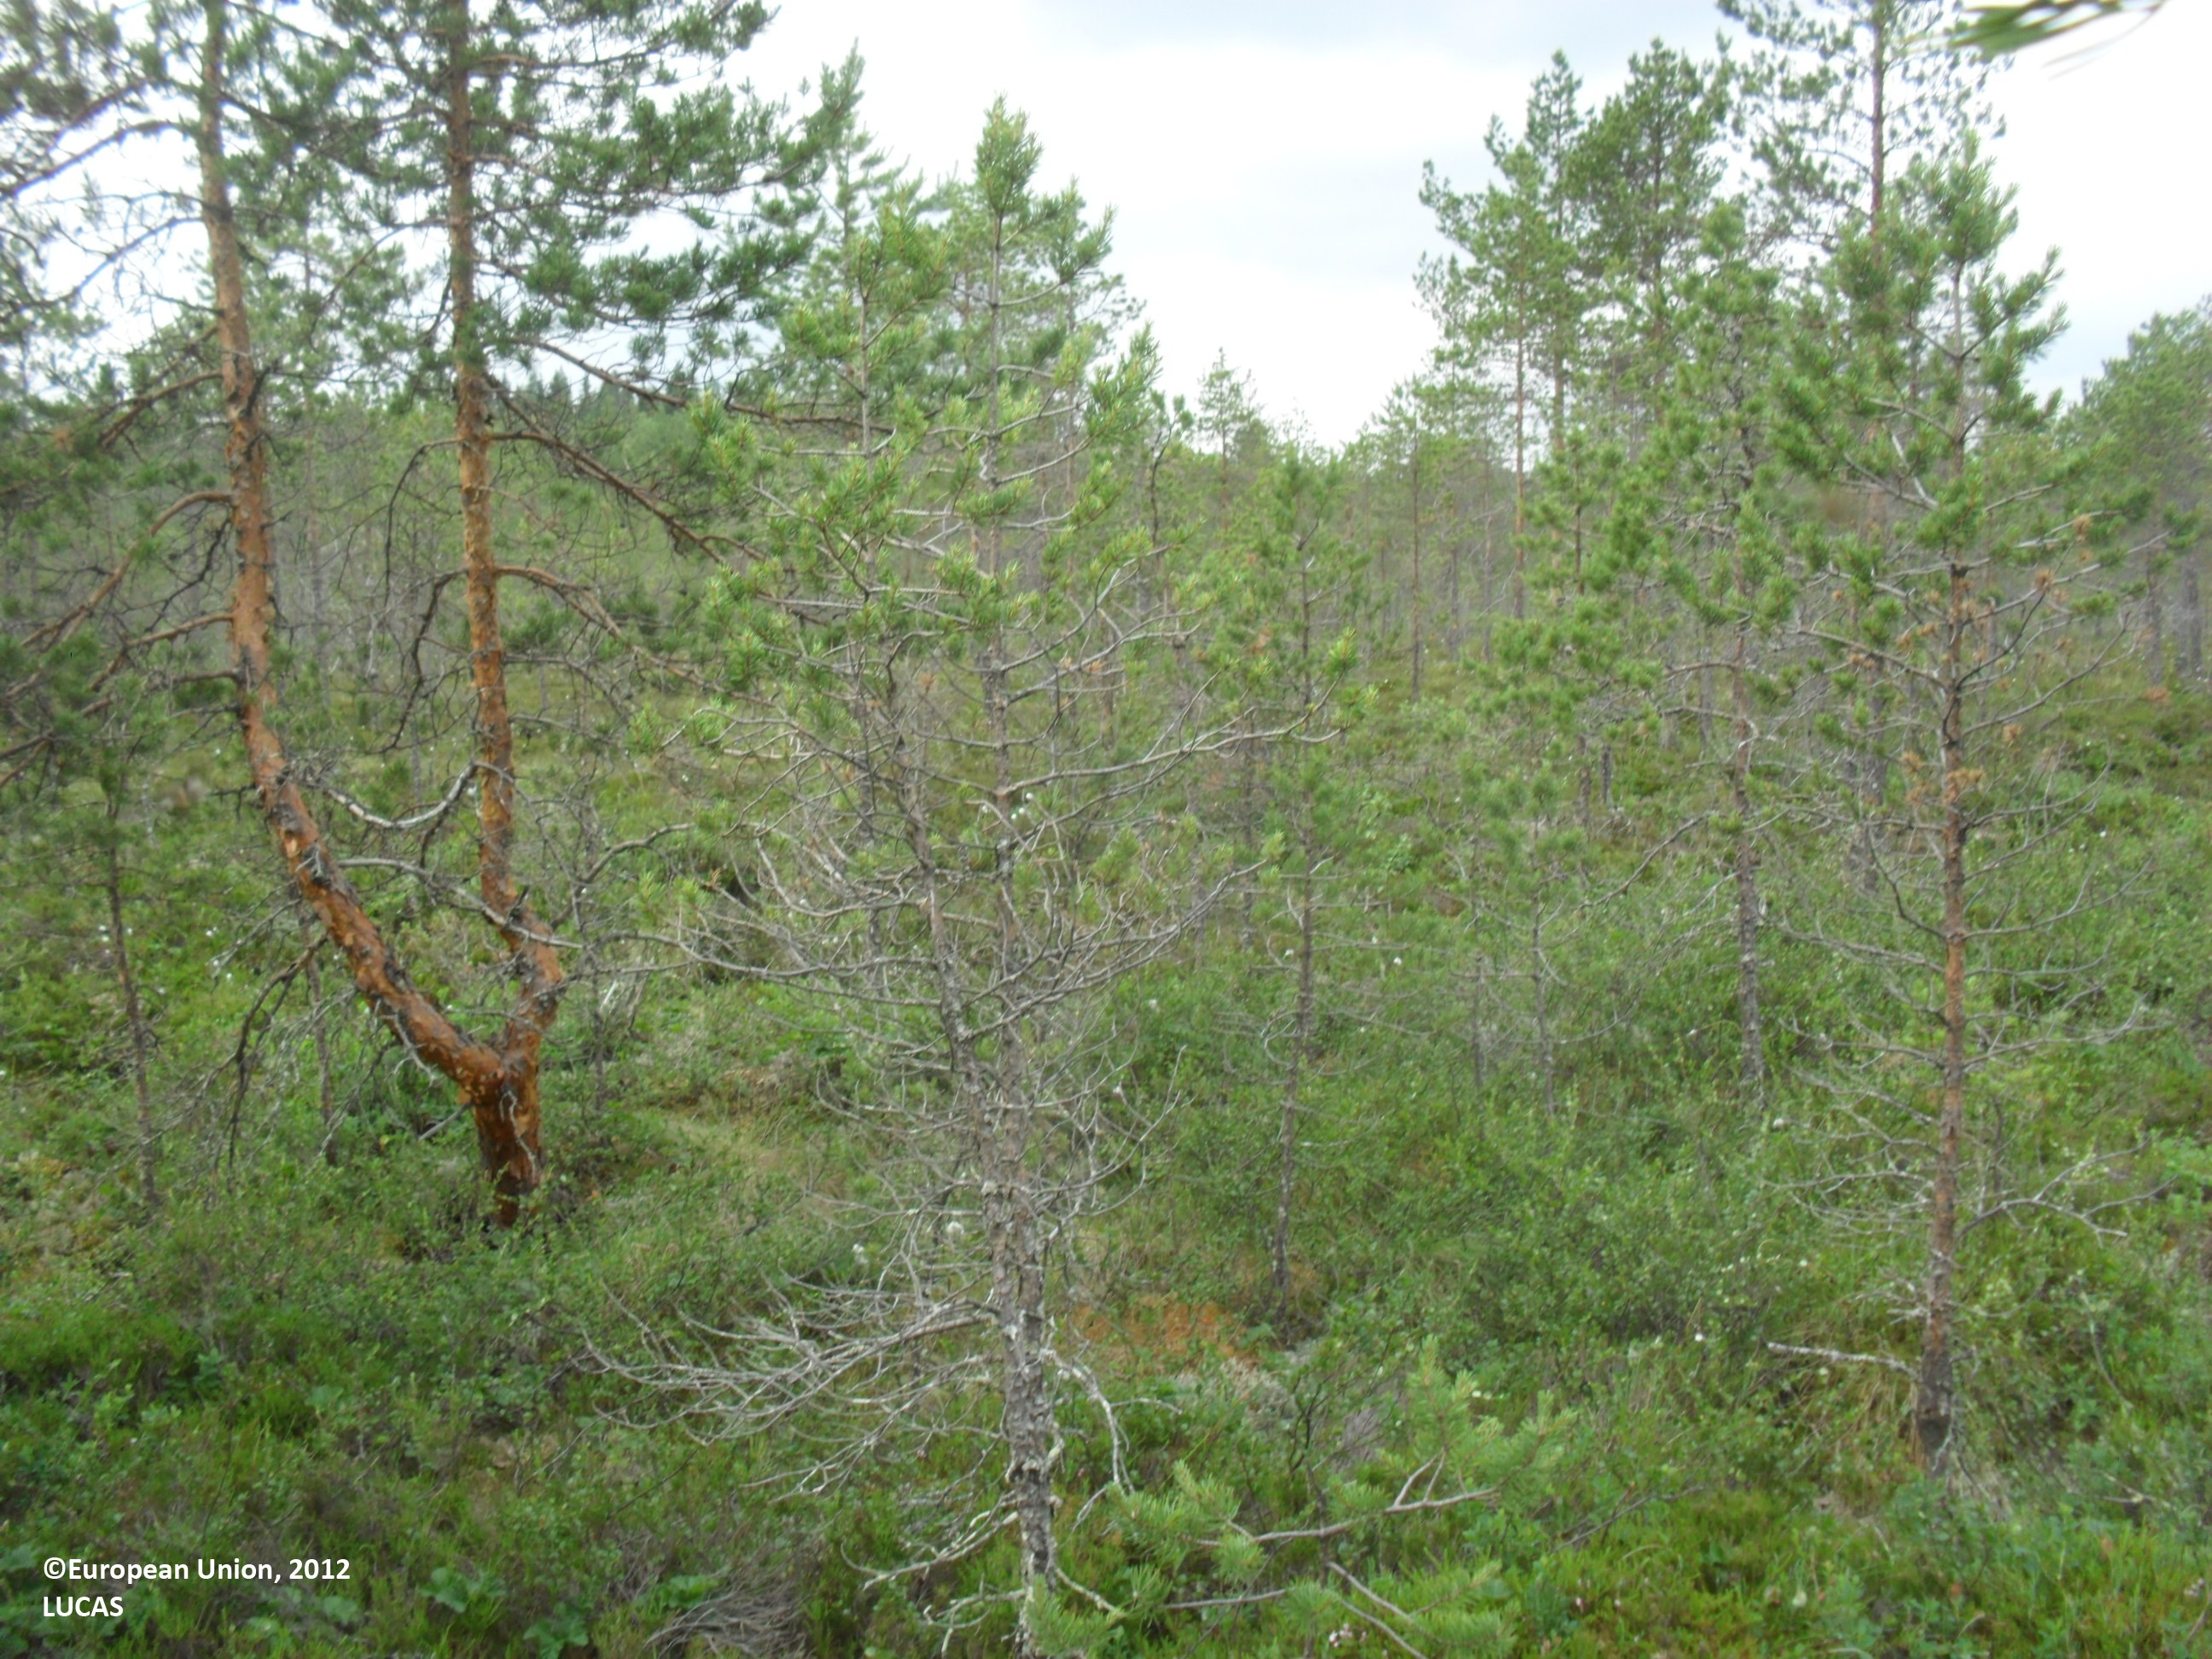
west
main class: Woodland
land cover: Pine dominated coniferous woodland
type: mire and swamp forests
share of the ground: 10 - 25 %
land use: Semi-natural and natural areas not in use
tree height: < 5 m
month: July
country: FI
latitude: 63.4878
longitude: 23.4950
